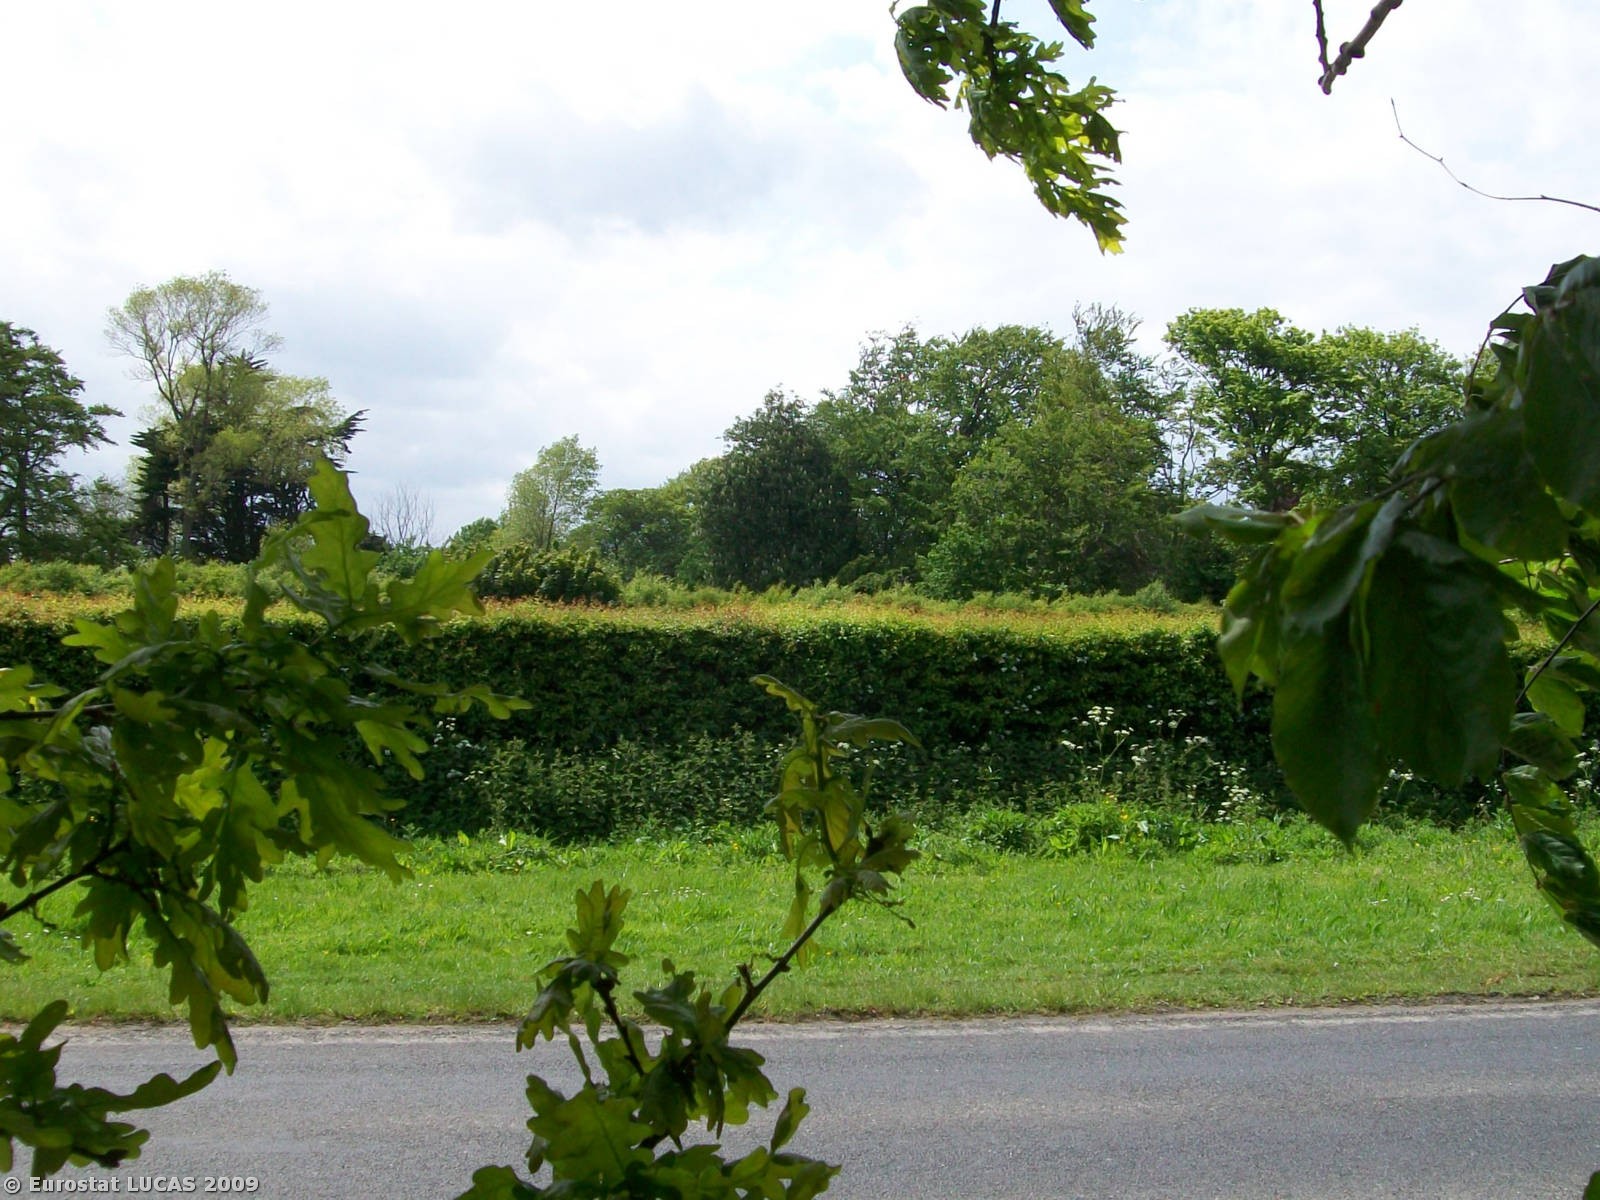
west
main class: Woodland
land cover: Broadleaved woodland
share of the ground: > 75 %
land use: Unused
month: May
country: GB
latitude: 52.6660
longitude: 1.7169
